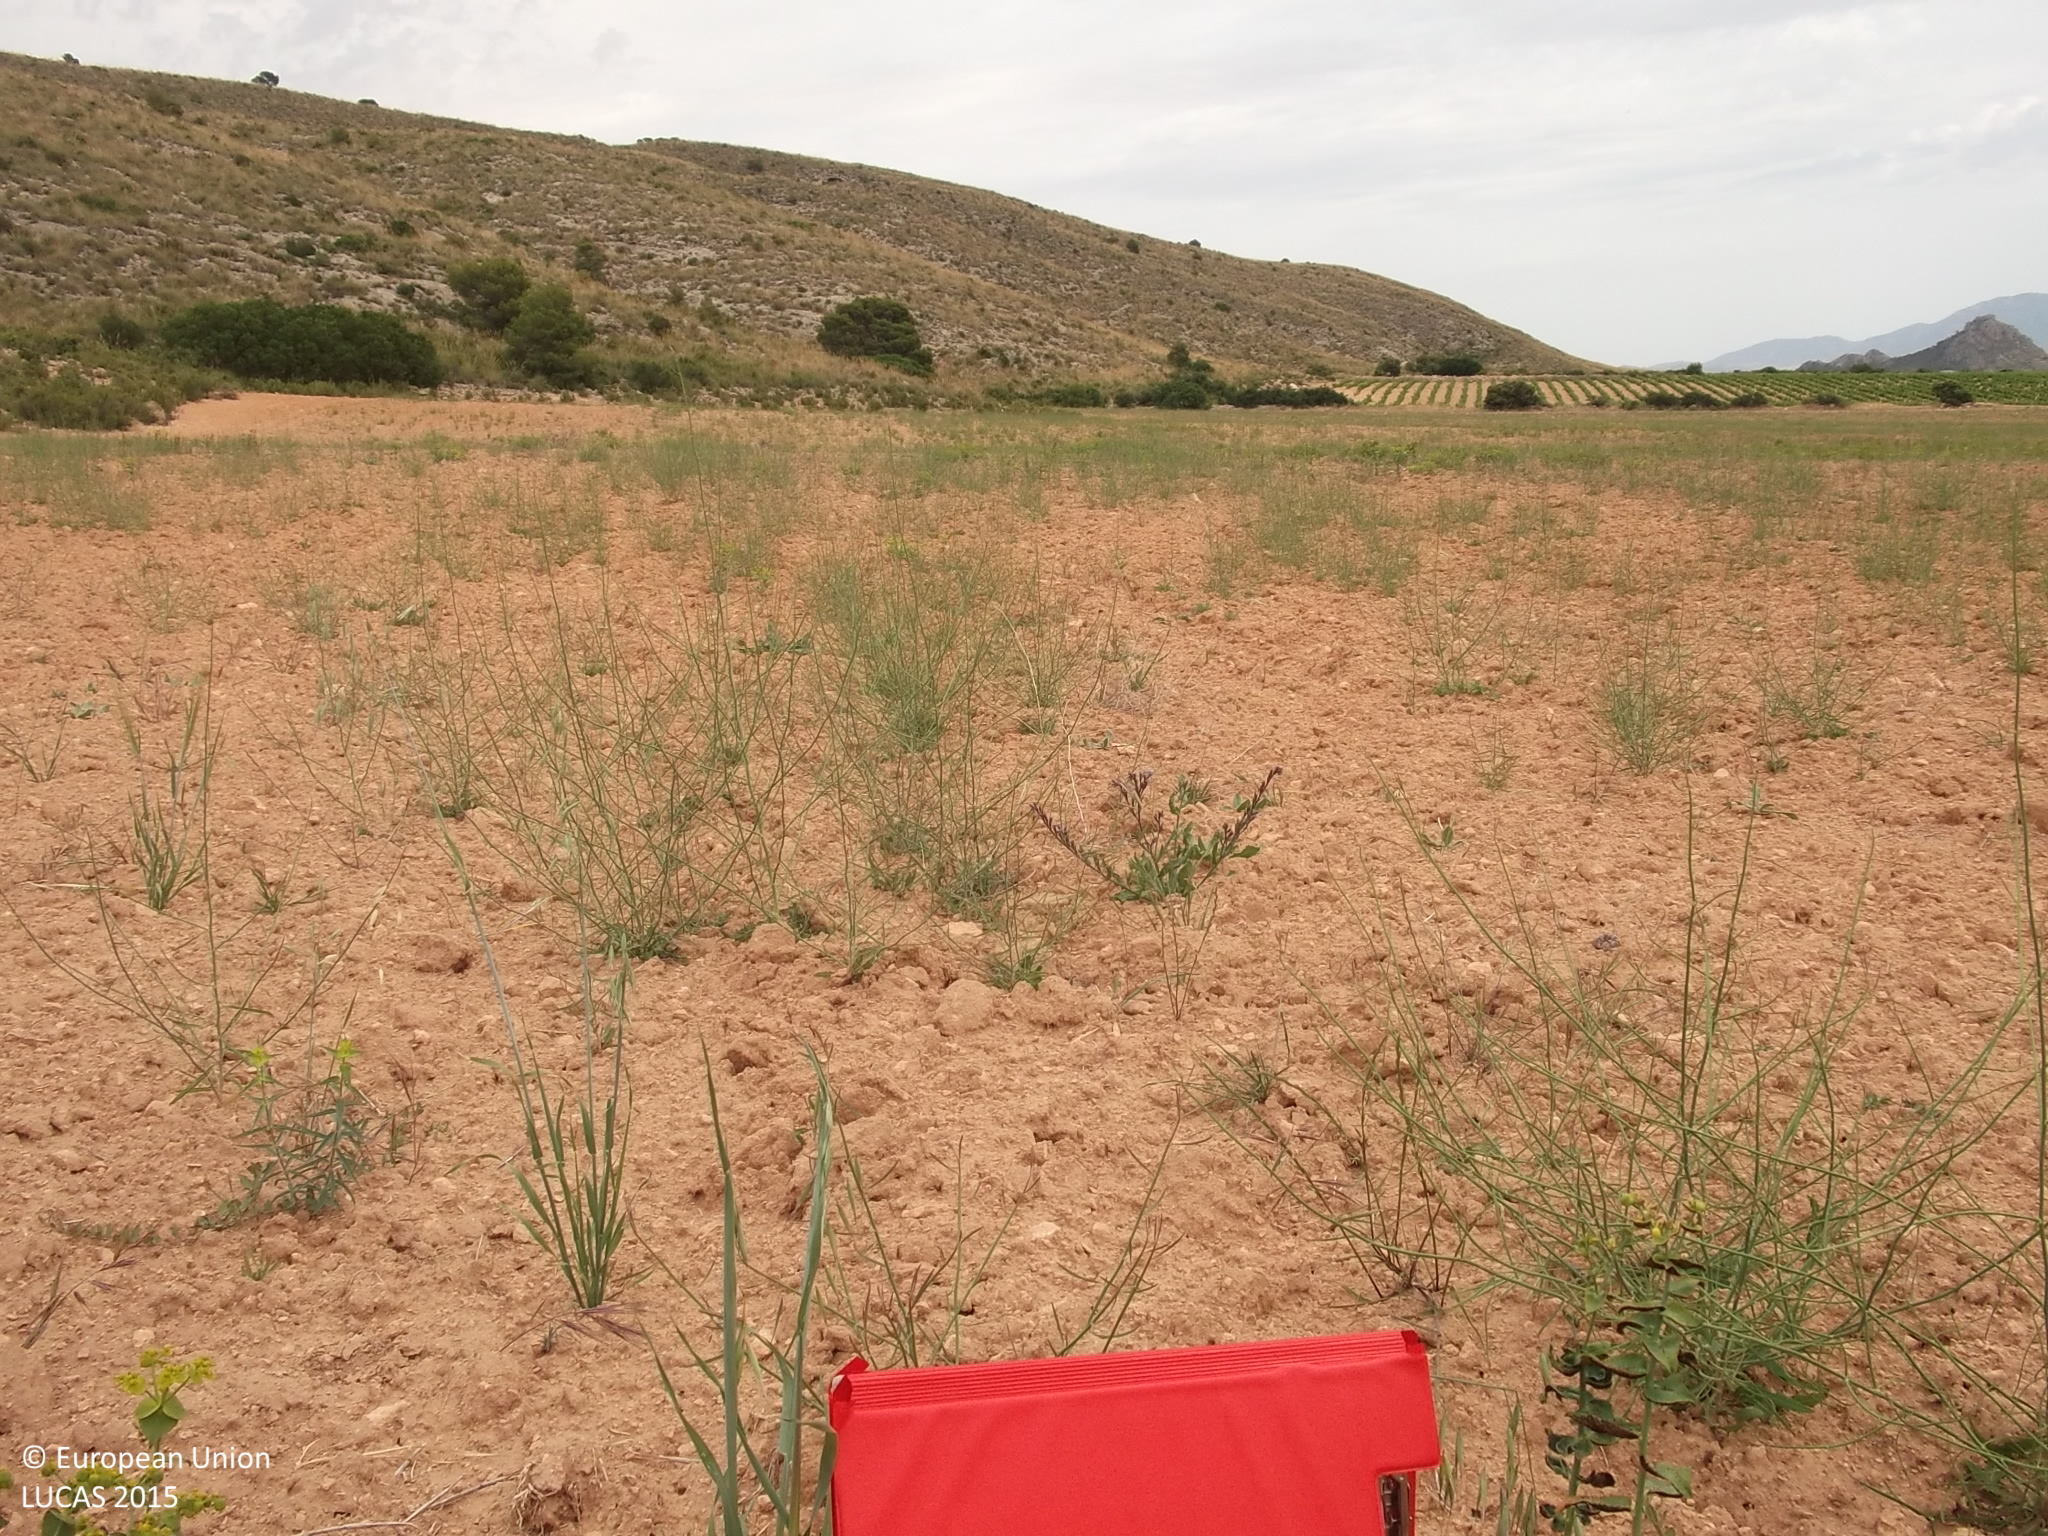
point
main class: Grassland
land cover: Spontaneously vegetated surfaces
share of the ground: 25 - 50 %
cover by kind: unconsolidated bare surface 70 %, herbaceous plants 30 %
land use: Fallow land
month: May
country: ES
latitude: 38.4811
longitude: -1.4434
